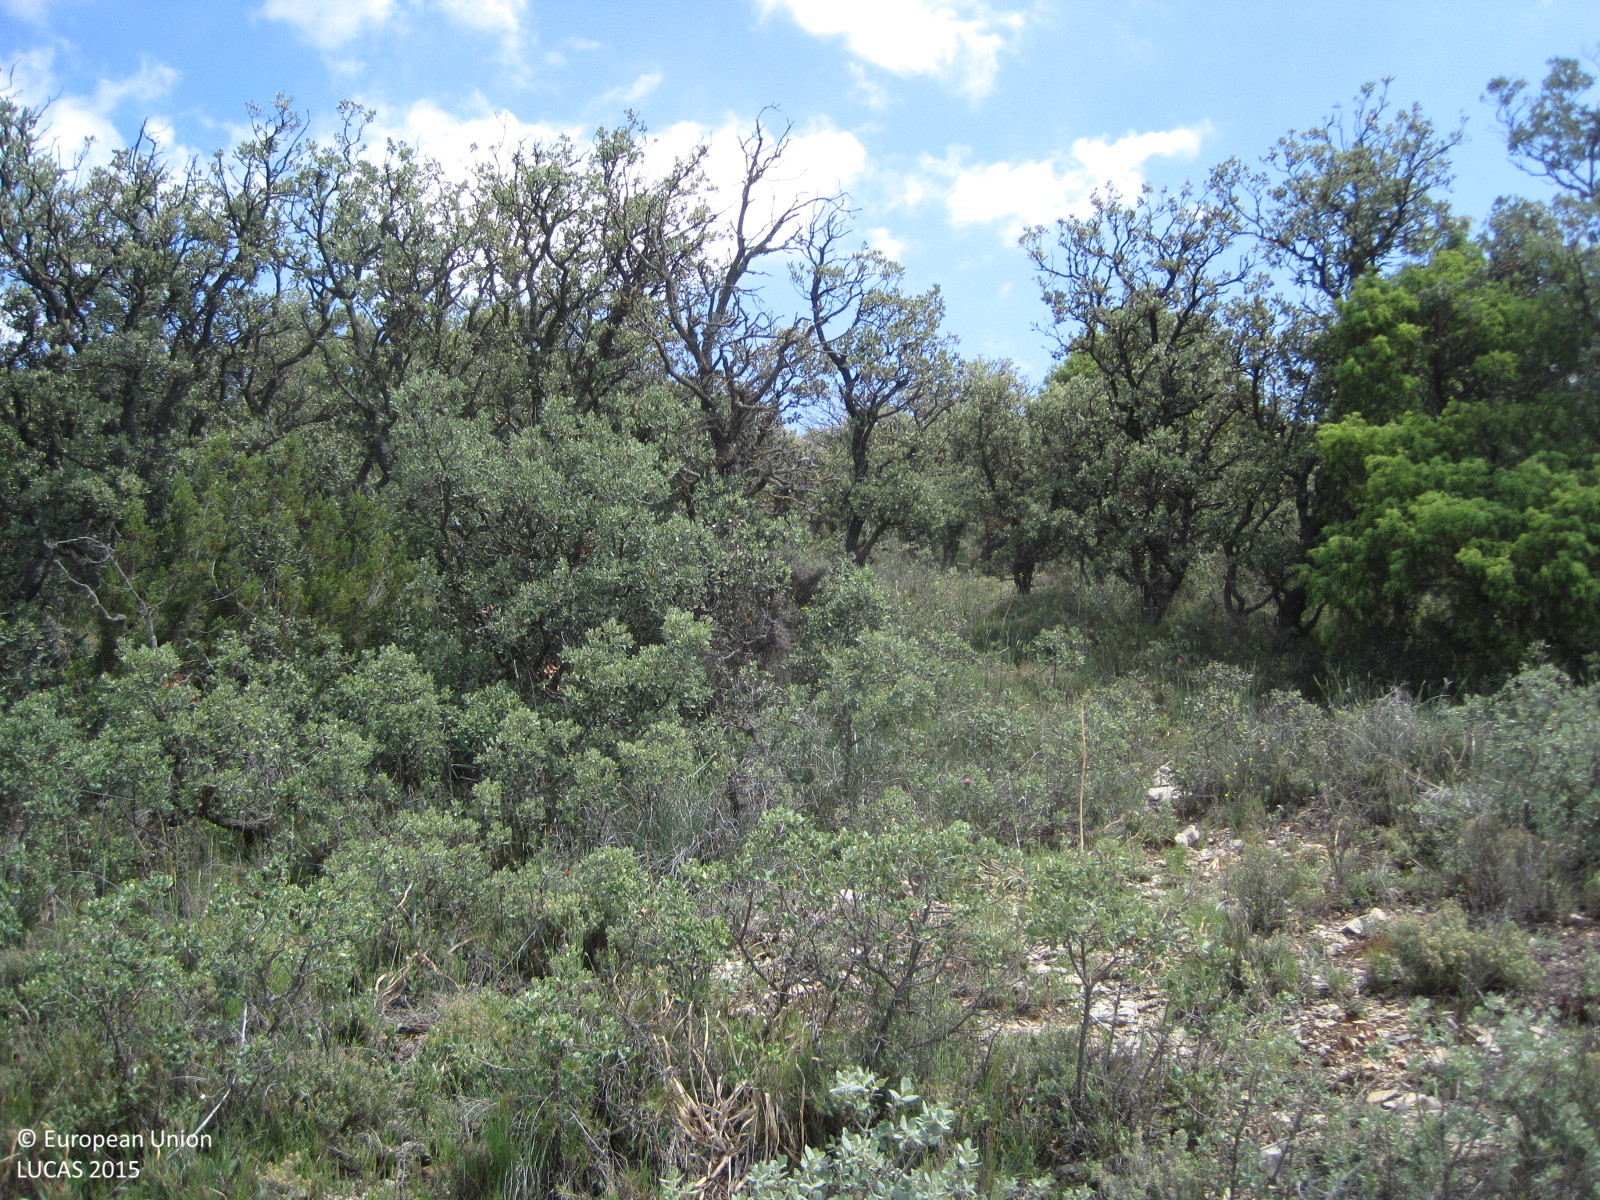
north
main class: Woodland
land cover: Broadleaved woodland
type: acidophilous oak and oak-birch forest
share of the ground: 25 - 50 %
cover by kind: broadleaved forest trees 30 %, consolidated bare surface 30 %, shrubs 15 %, herbaceous plants 15 %, coniferous forest trees 10 %
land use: Forestry
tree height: < 5 m
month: June
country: ES
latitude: 39.9473
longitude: -0.7605
